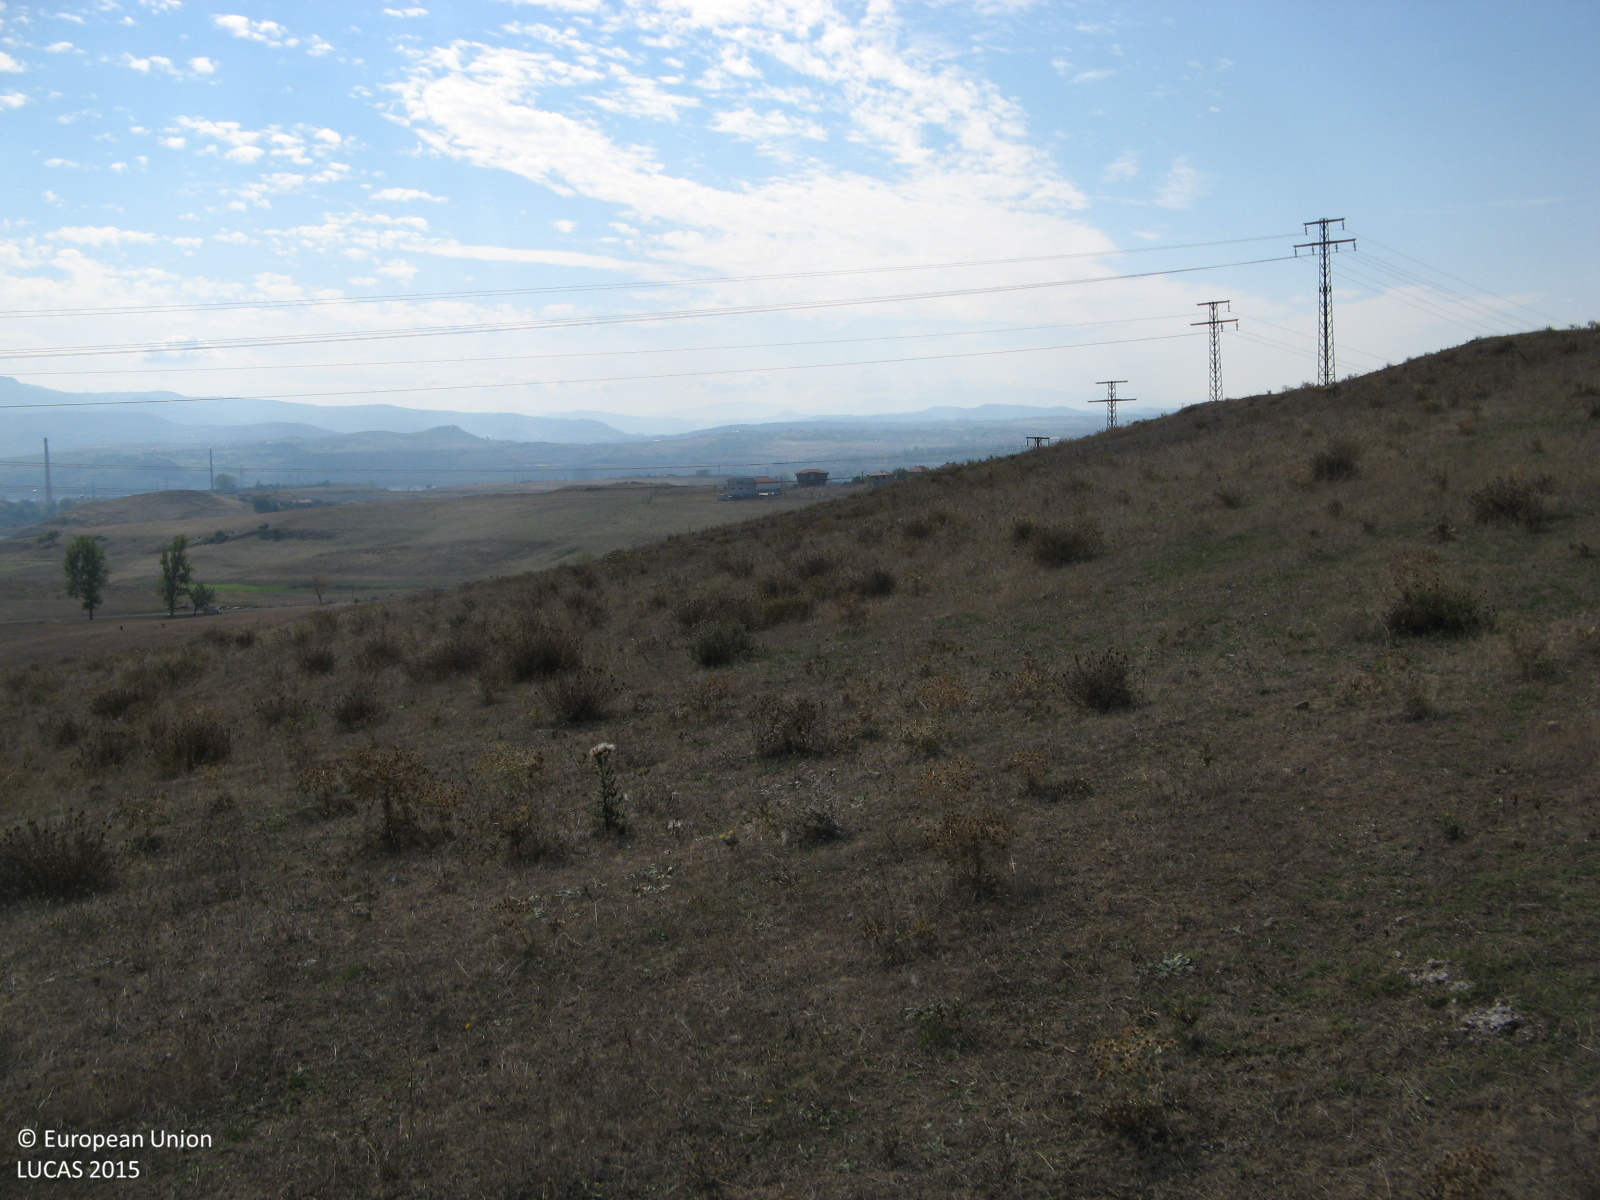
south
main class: Grassland
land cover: Grassland without tree/shrub cover
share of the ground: > 75 %
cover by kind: herbaceous plants 100 %
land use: Agriculture (excluding fallow land and kitchen gardens)
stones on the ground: < 10 %
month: October
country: BG
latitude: 41.6530
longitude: 25.3913
